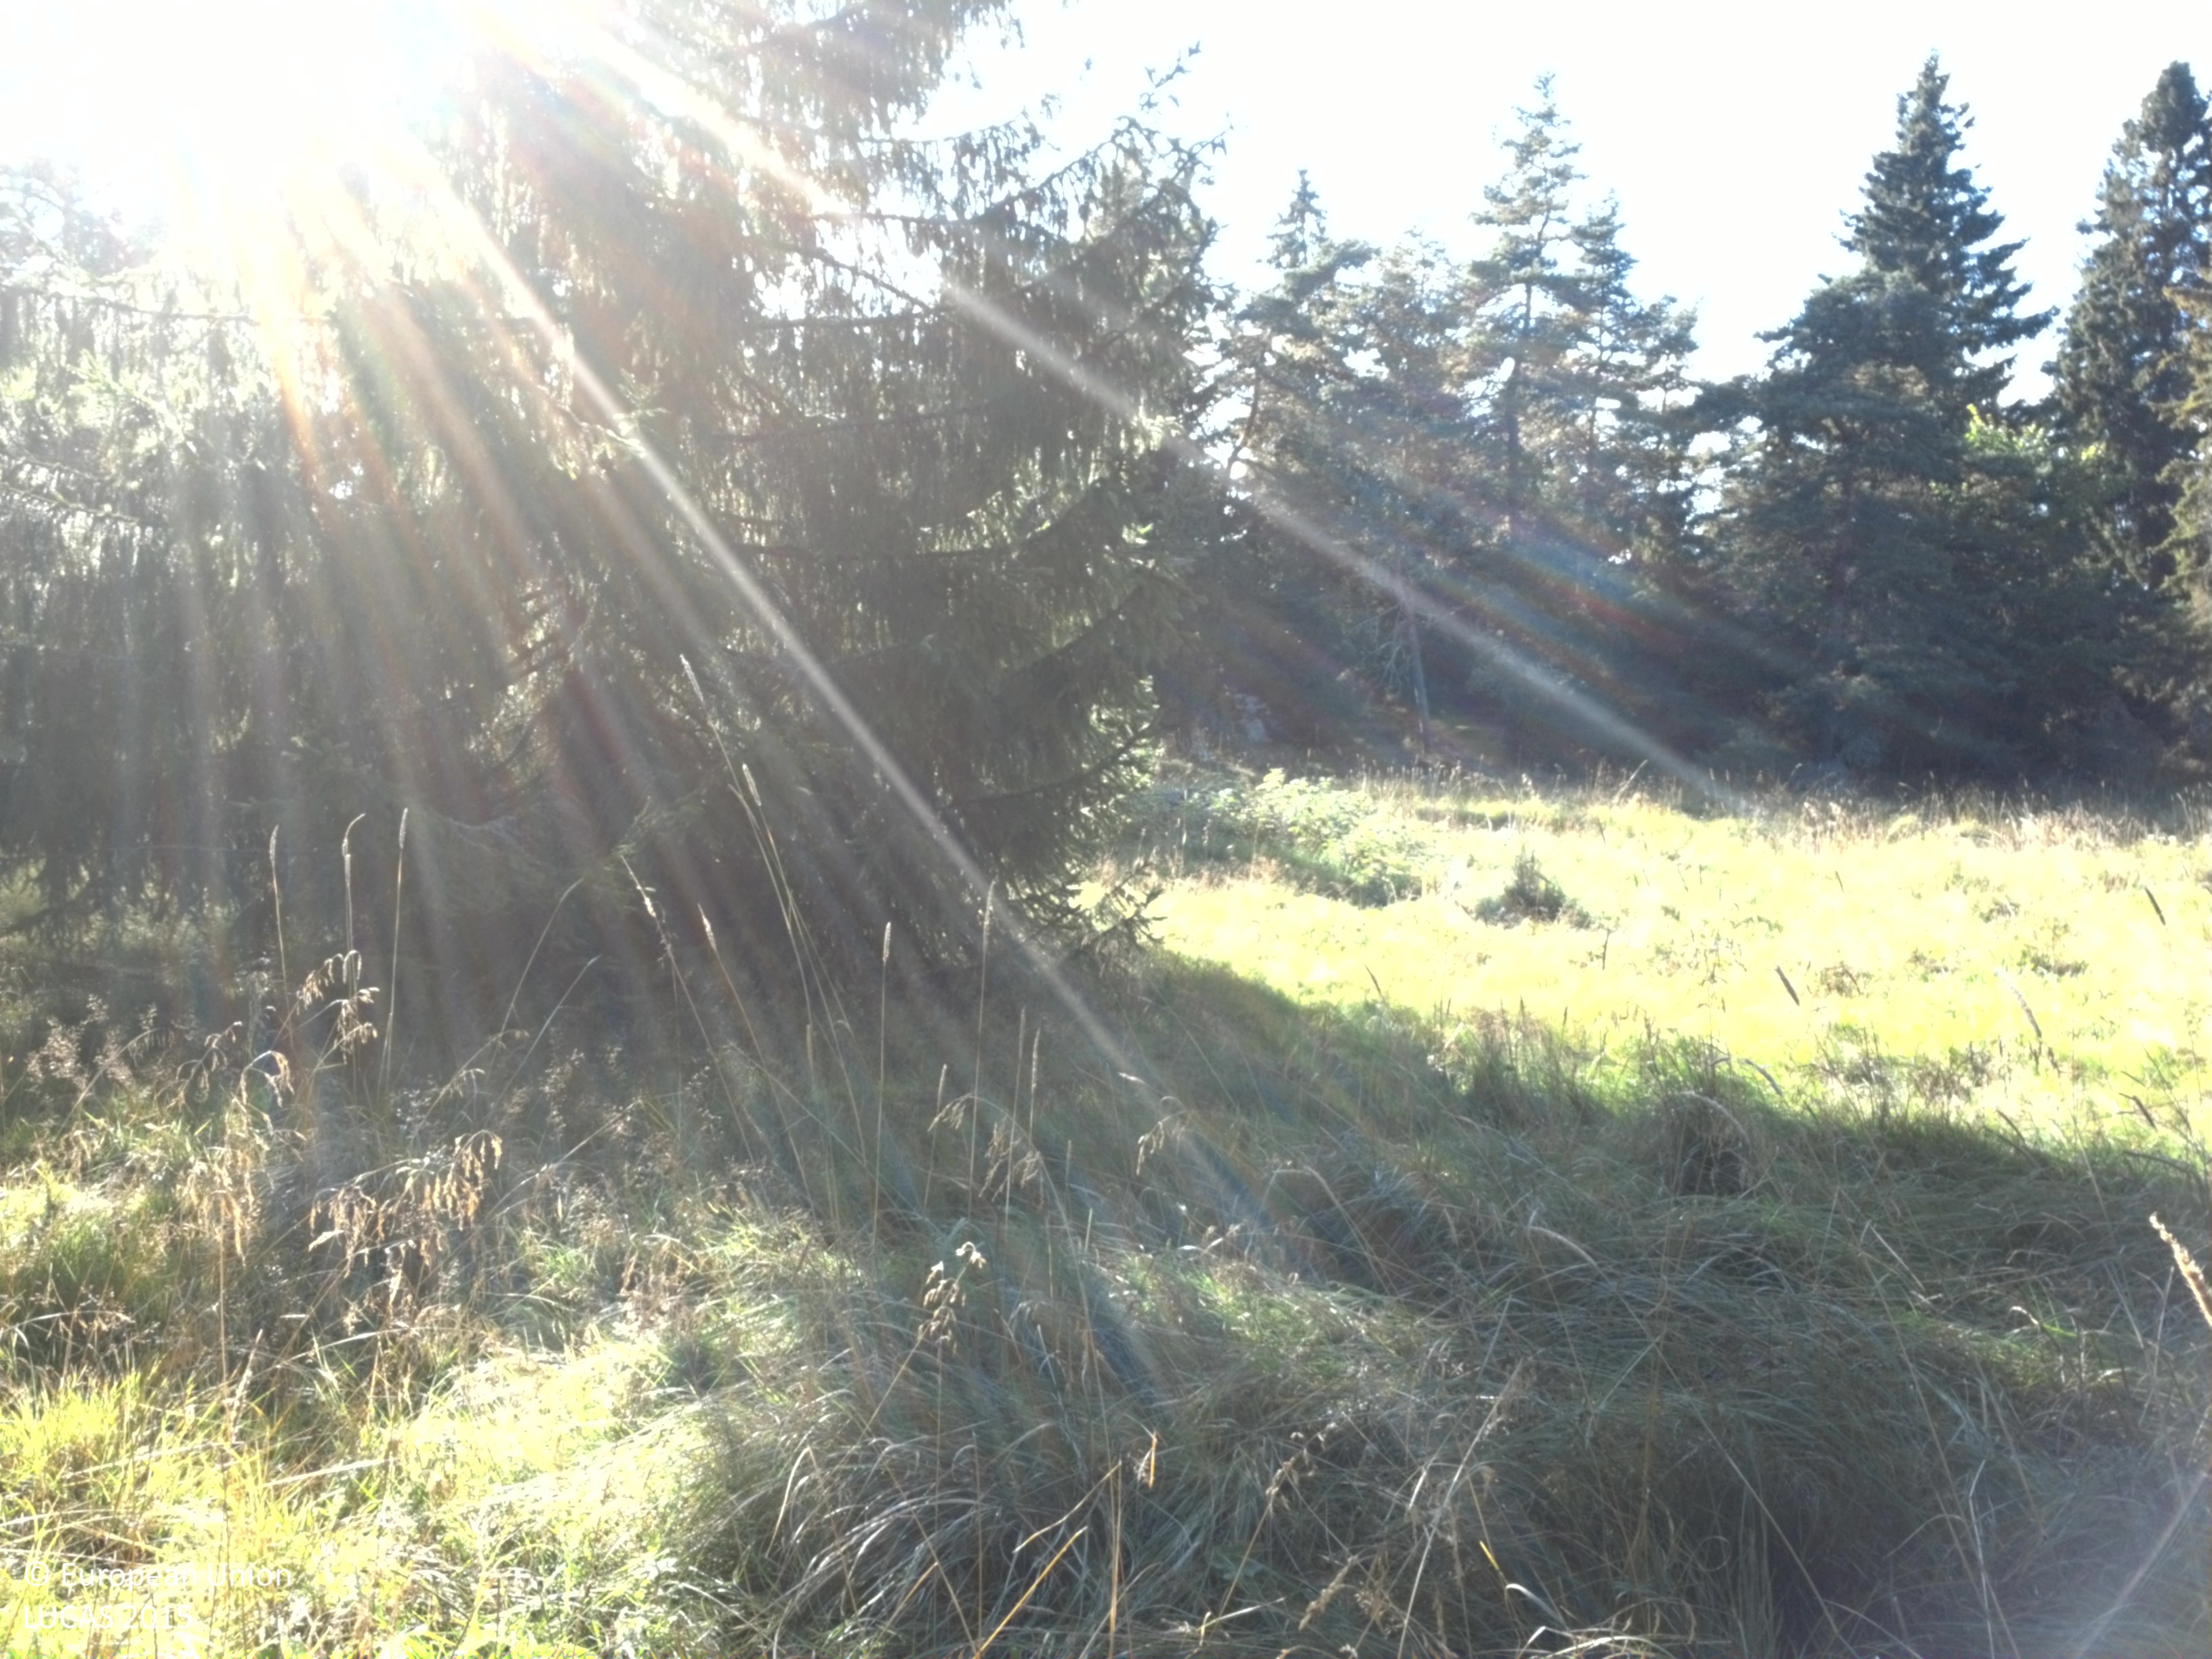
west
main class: Grassland
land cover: Grassland with sparse tree/shrub cover
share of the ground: > 75 %
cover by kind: herbaceous plants 95 %, coniferous forest trees 5 %
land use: Fallow land
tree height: > 5 m
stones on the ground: < 10 %
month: August
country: SE
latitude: 59.8582
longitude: 17.7613
